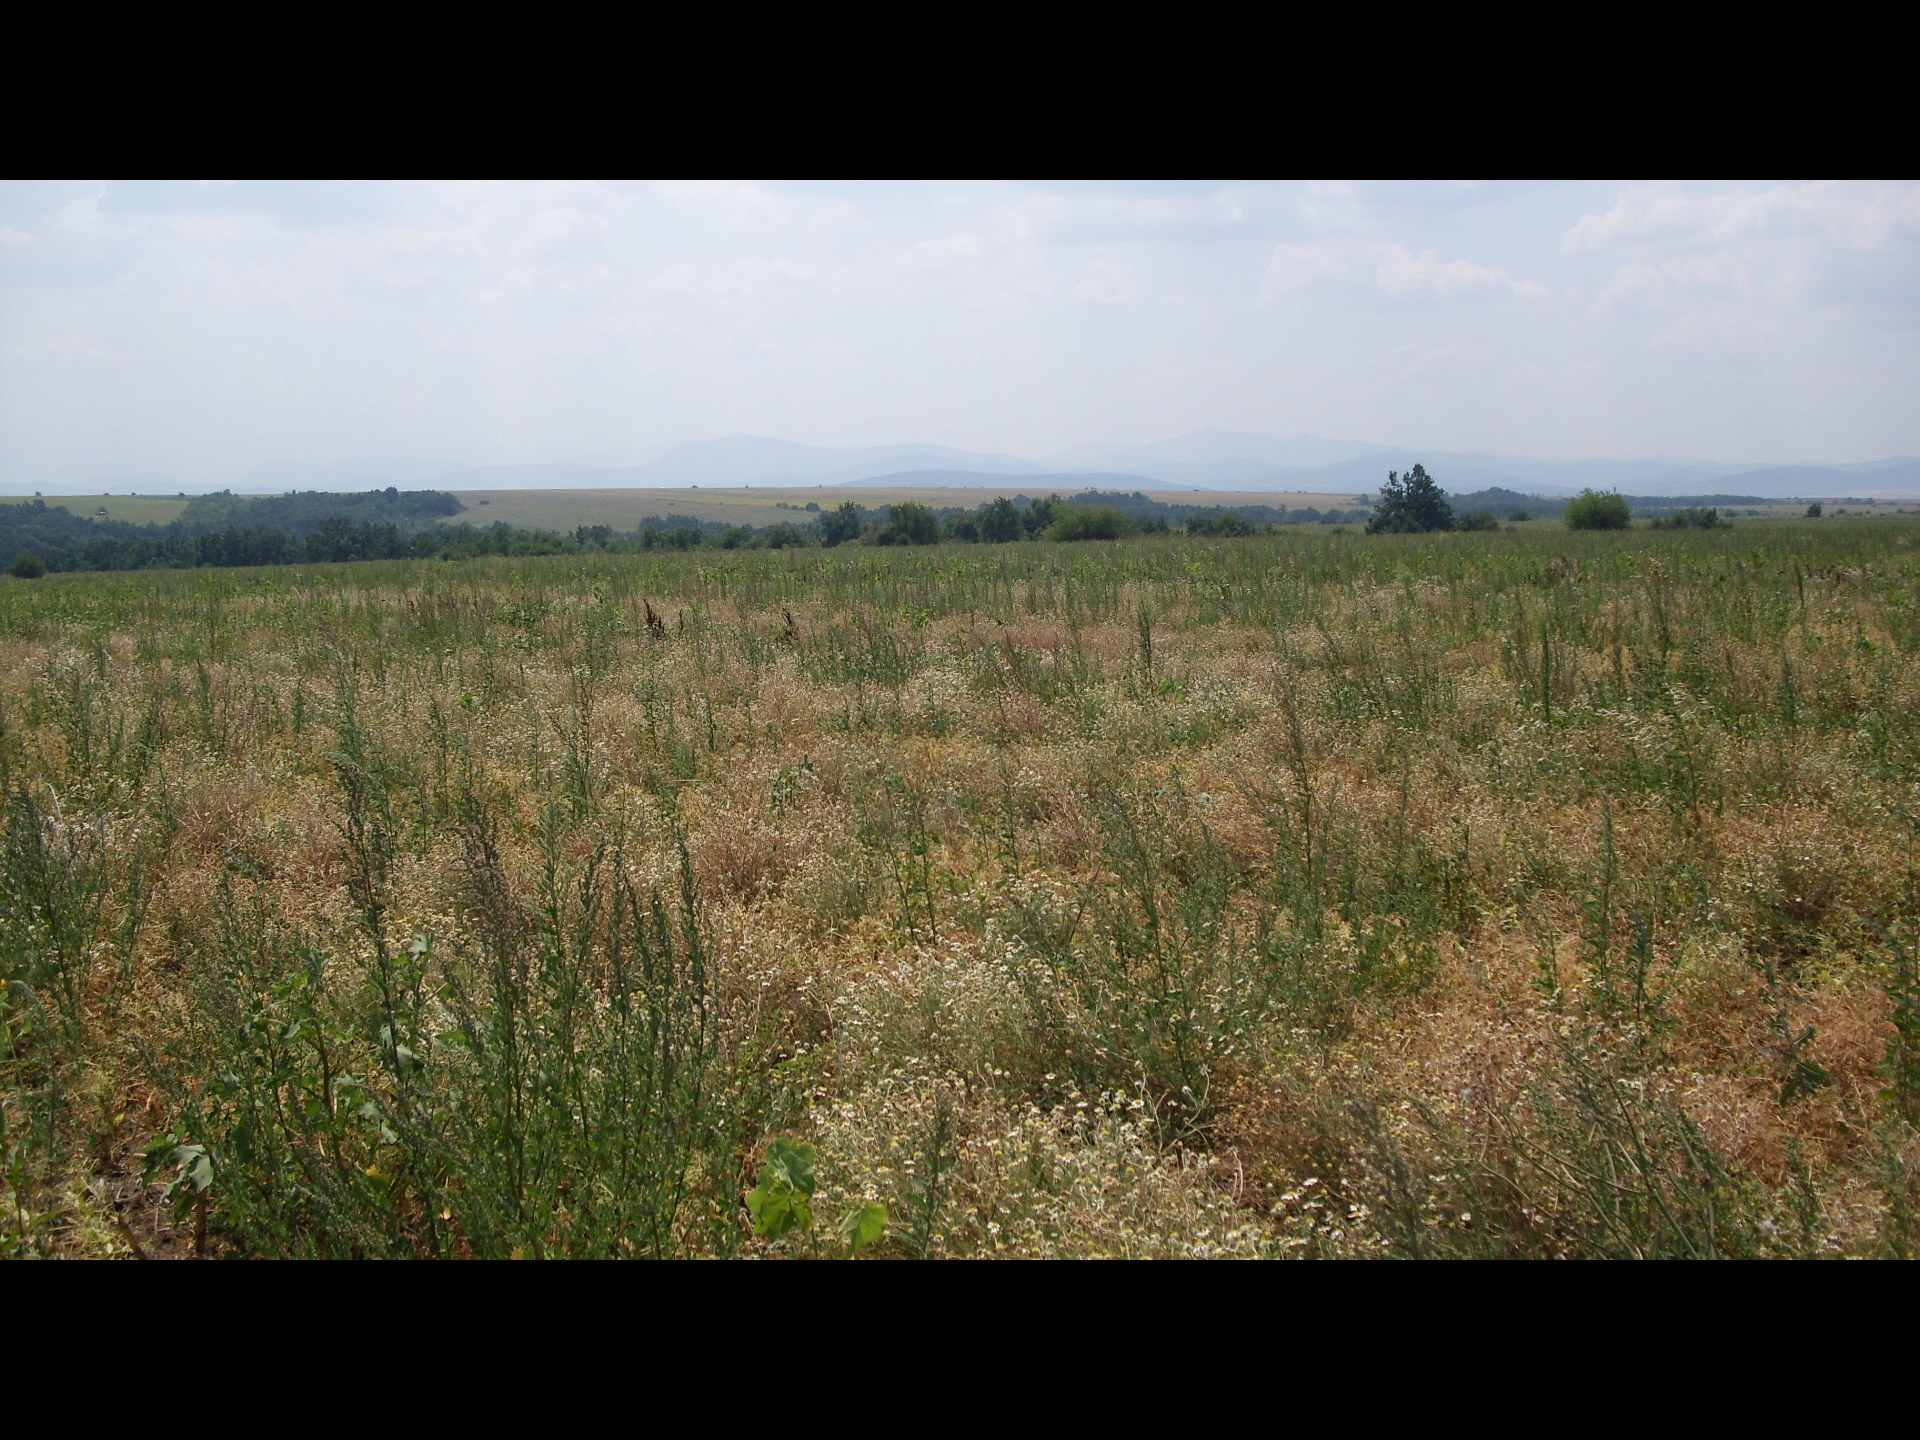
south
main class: Grassland
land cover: Spontaneously vegetated surfaces
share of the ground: > 75 %
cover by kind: herbaceous plants 100 %
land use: Fallow land
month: July
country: BG
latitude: 43.8158
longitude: 22.6036
